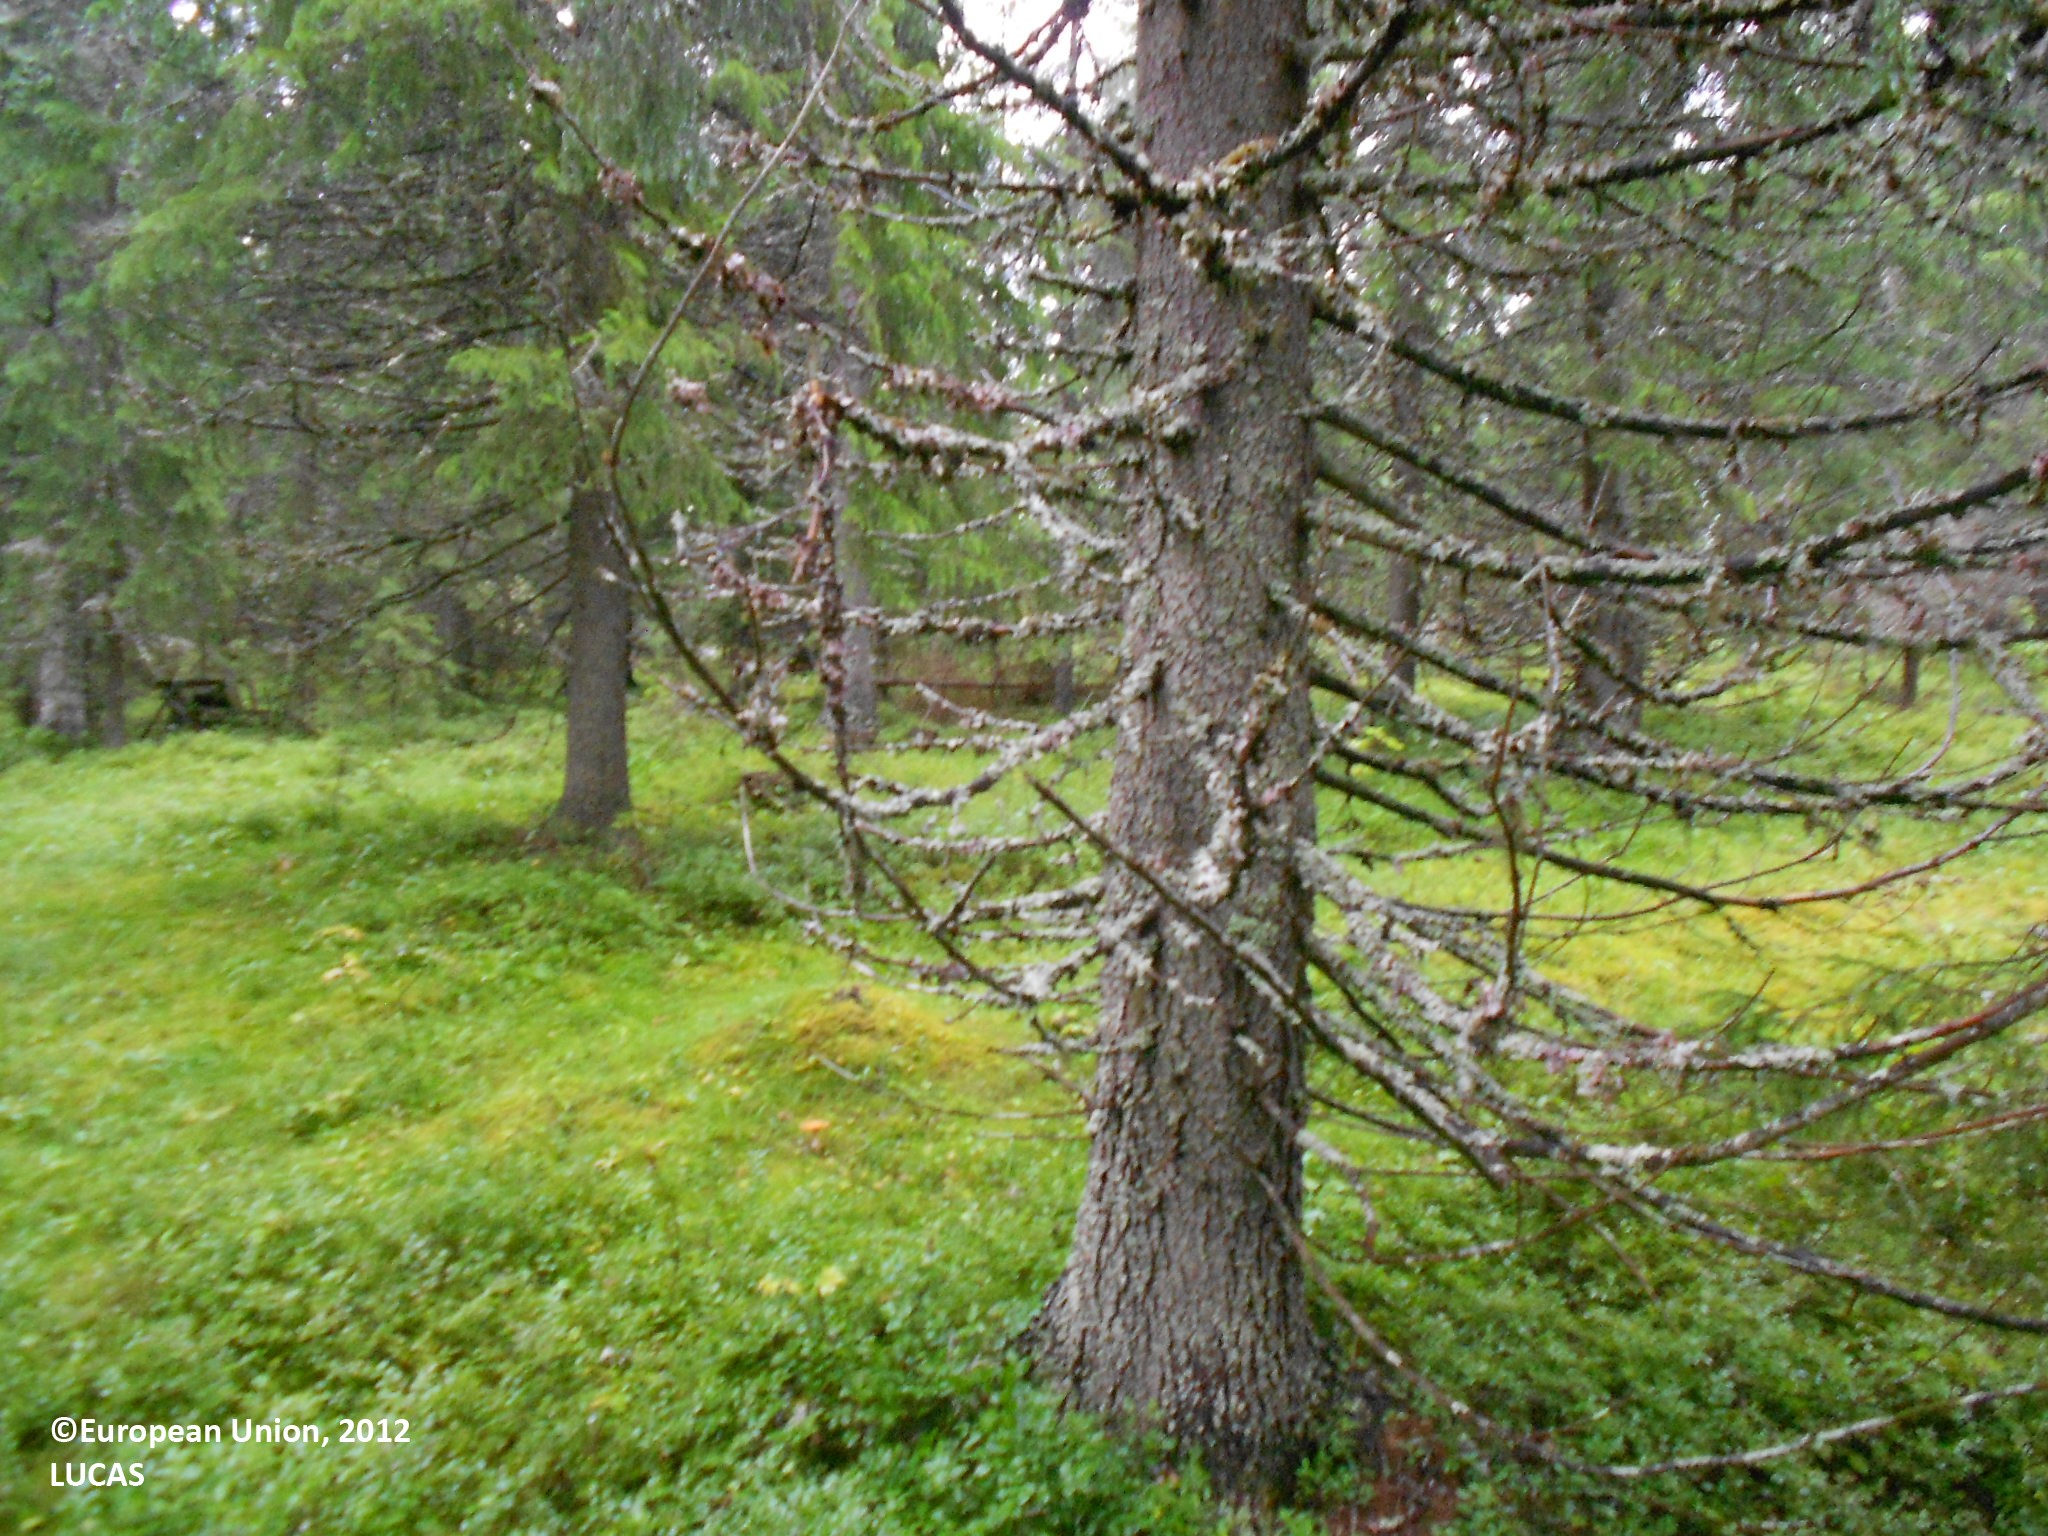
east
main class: Woodland
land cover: Spruce dominated coniferous woodland
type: boreal forest
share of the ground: 50 - 75 %
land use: Forestry
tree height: > 5 m
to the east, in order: Spruce dominated coniferous woodland
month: August
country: FI
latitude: 63.8984
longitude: 28.2874
